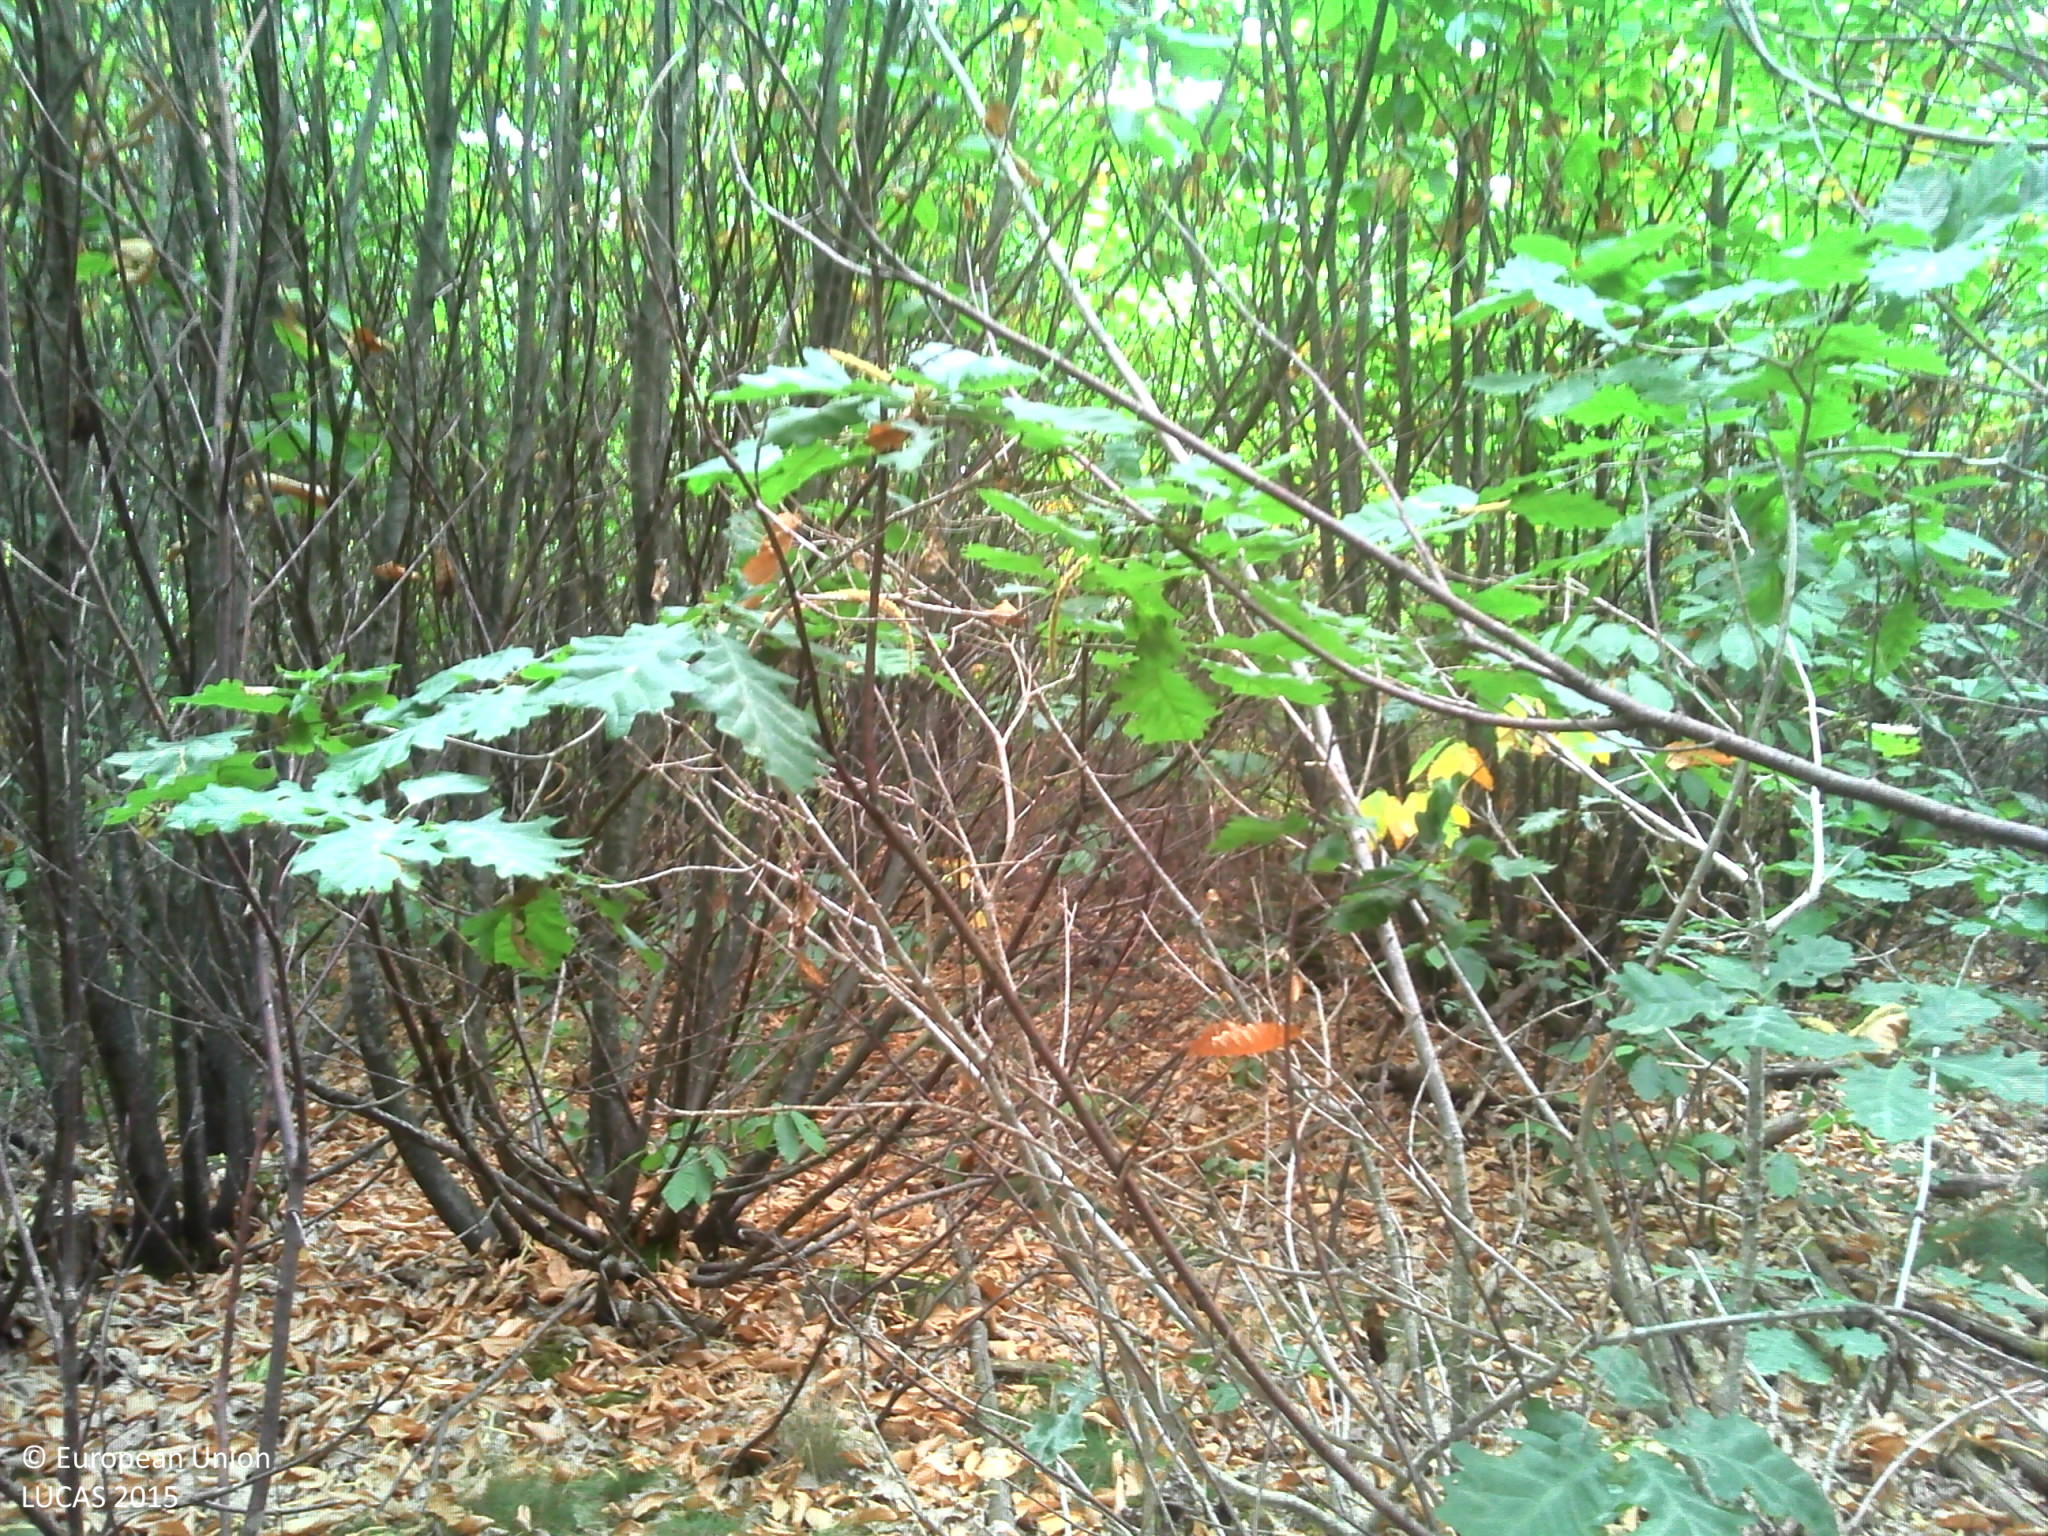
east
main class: Woodland
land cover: Broadleaved woodland
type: acidophilous oak and oak-birch forest
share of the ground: > 75 %
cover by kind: broadleaved forest trees 55 %, lichens and mosses 20 %, herbaceous plants 15 %, unconsolidated bare surface 10 %
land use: Forestry
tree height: > 5 m
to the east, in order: Broadleaved woodland; Tracks; Broadleaved woodland
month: July
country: FR
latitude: 45.5576
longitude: 1.4741
